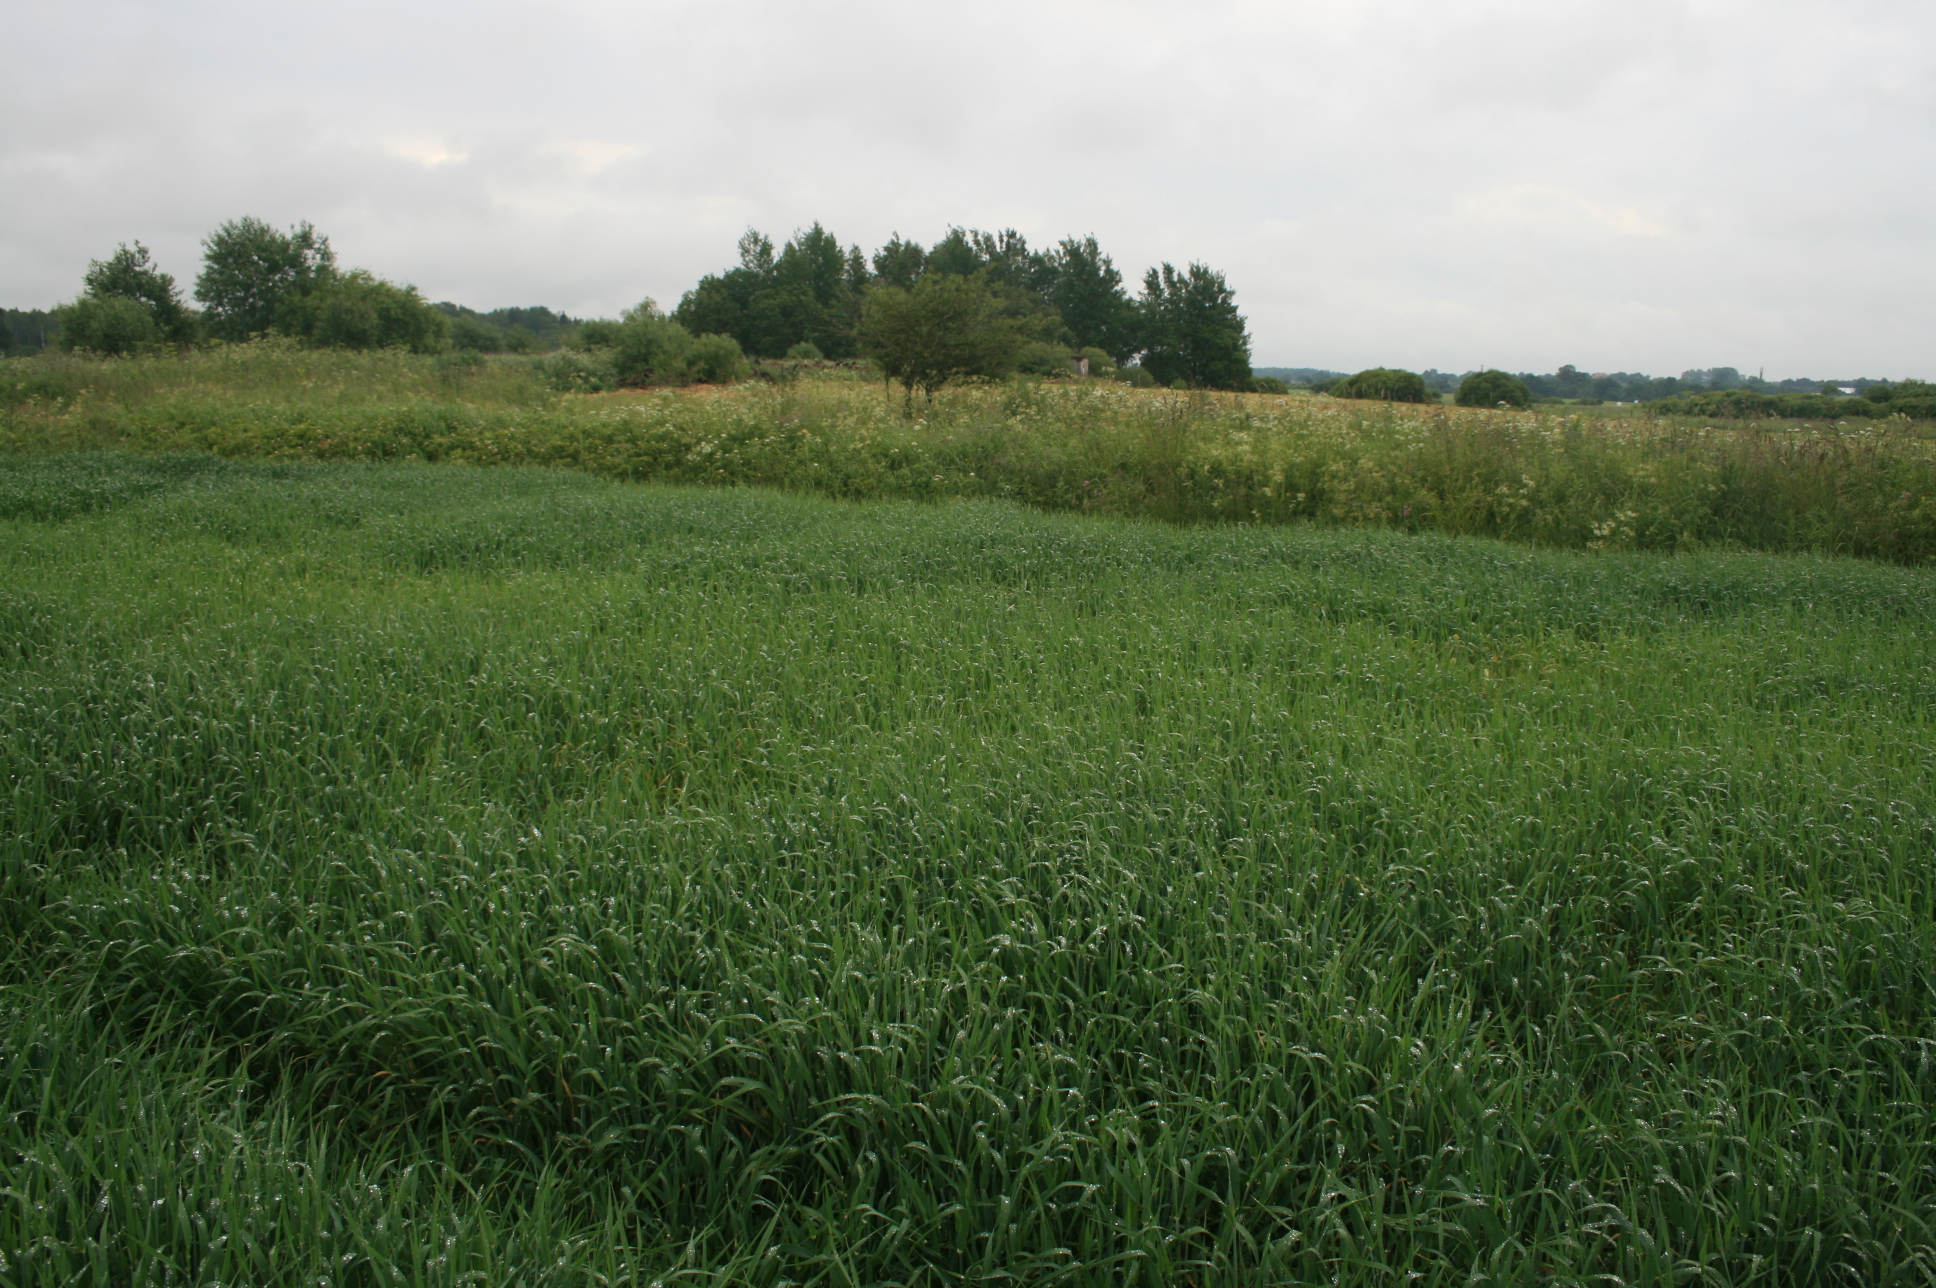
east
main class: Cropland
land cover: Barley
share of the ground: > 75 %
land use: Agriculture (excluding fallow land and kitchen gardens)
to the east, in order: Barley; Grassland with sparse tree/shrub cover; Paved roads, cycling and walking lanes; Broadleaved woodland; Grassland without tree/shrub cover; Grassland with sparse tree/shrub cover; Grassland without tree/shrub cover; Fences; Other fruit trees and berries; Fences; Grassland without tree/shrub cover
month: June
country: LT
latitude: 55.2514
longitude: 22.4416
